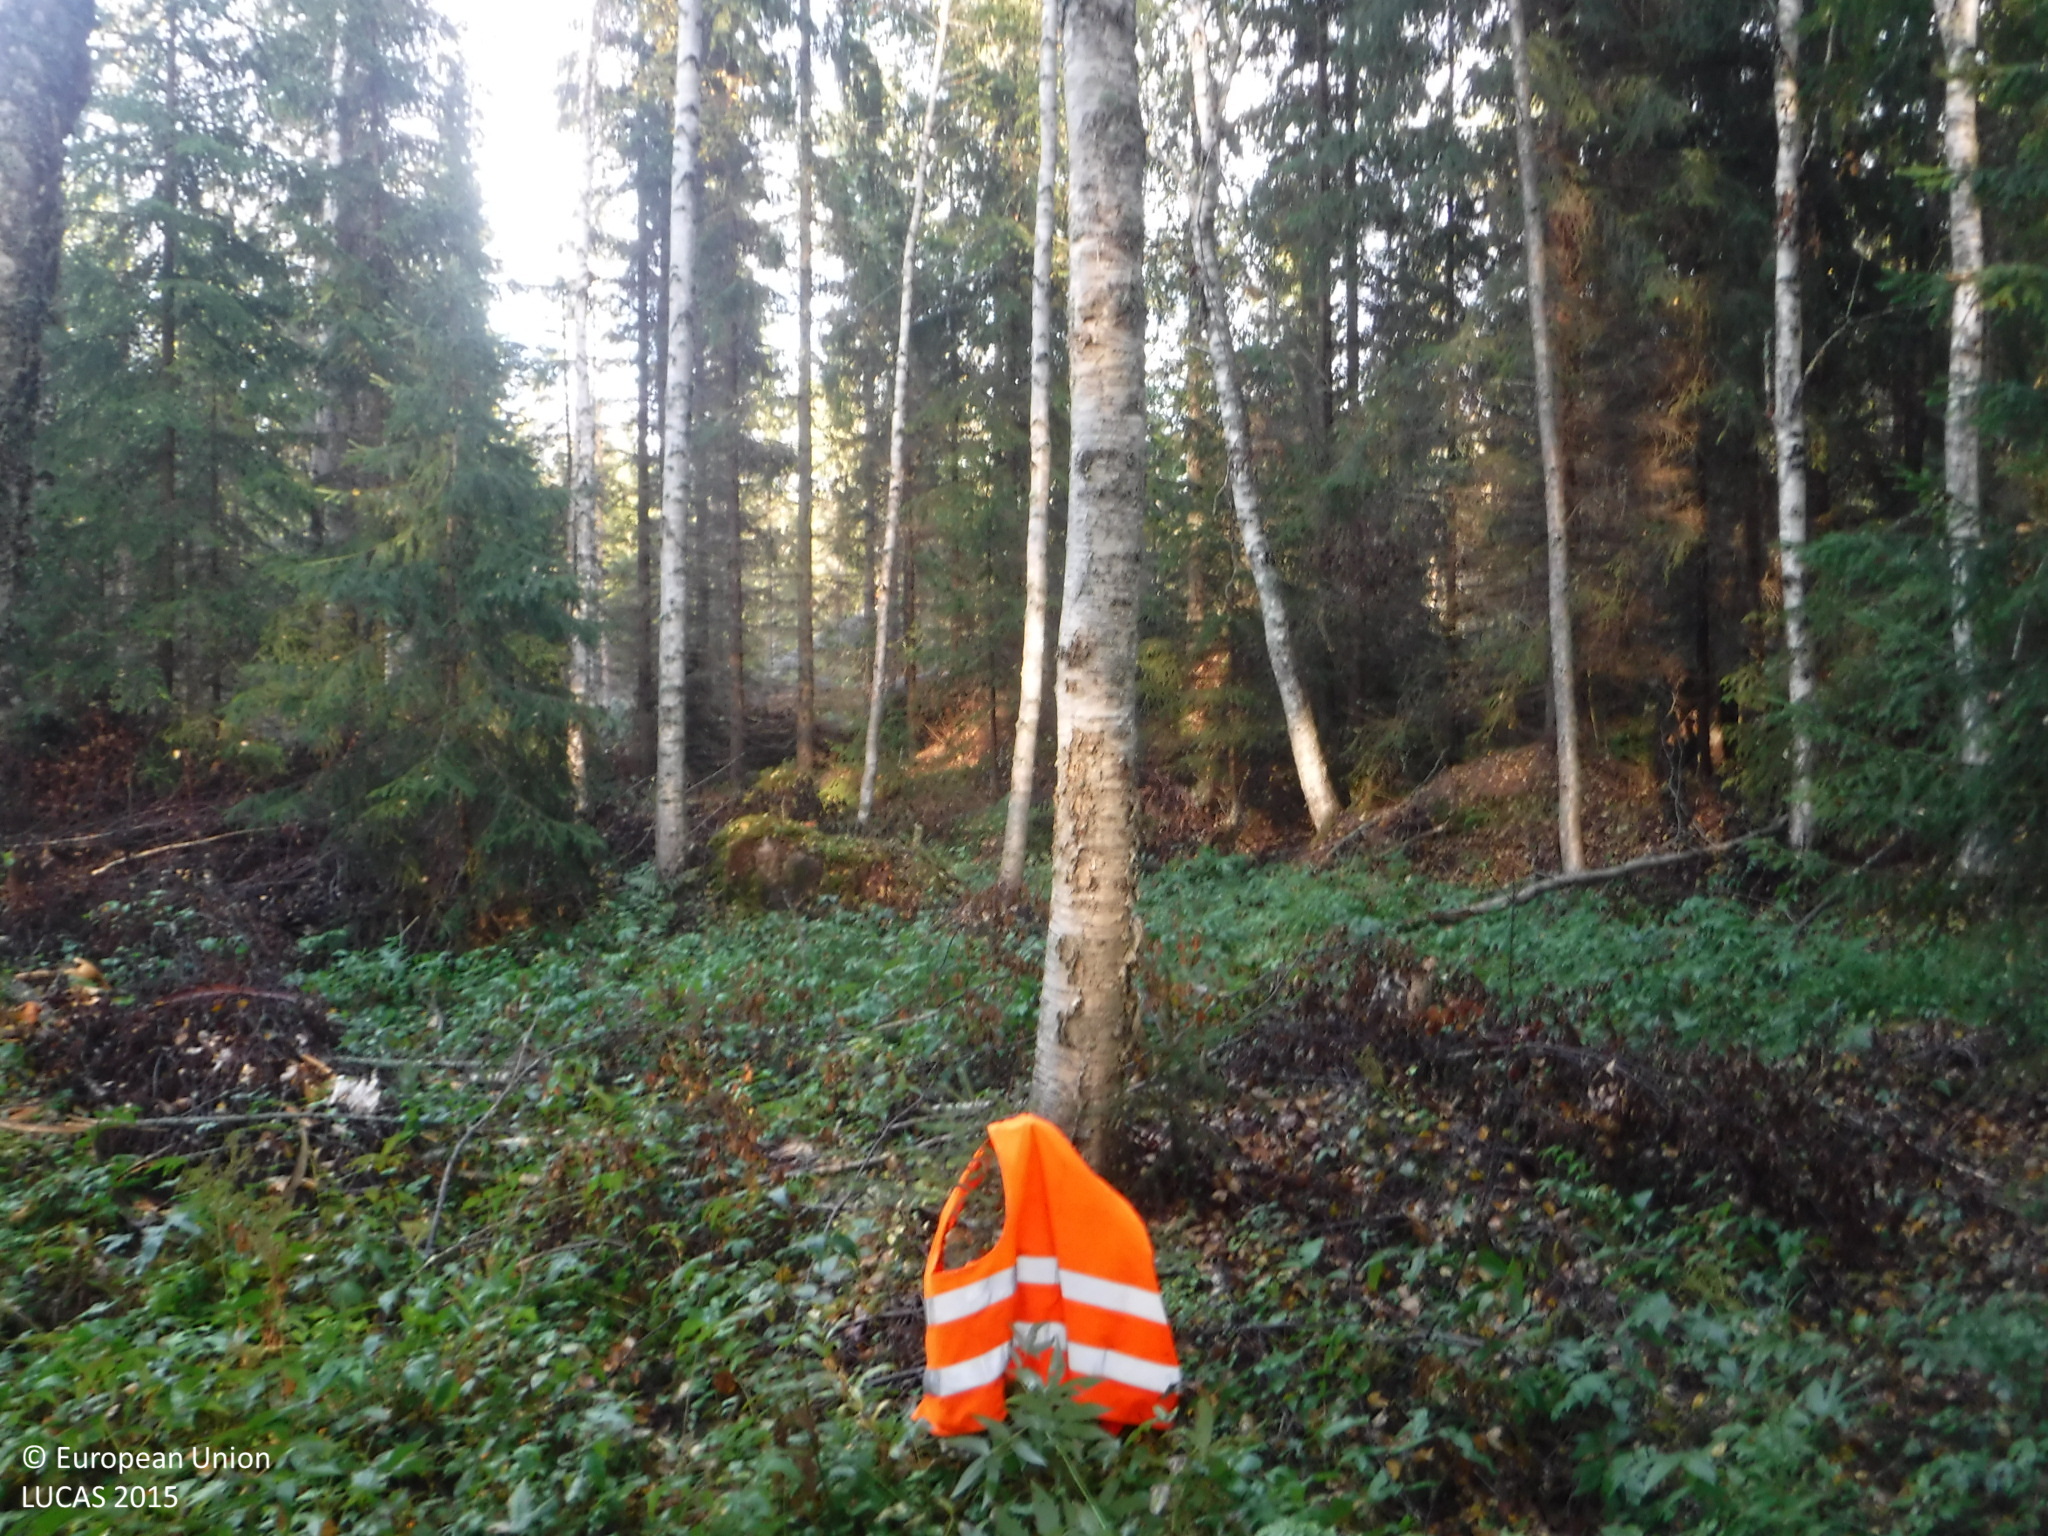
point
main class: Woodland
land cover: Spruce dominated mixed woodland
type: boreal forest
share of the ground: 50 - 75 %
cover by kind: coniferous forest trees 35 %, herbaceous plants 35 %, broadleaved forest trees 20 %, shrubs 10 %
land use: Forestry
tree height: > 5 m
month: September
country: FI
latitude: 61.7205
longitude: 21.6491
